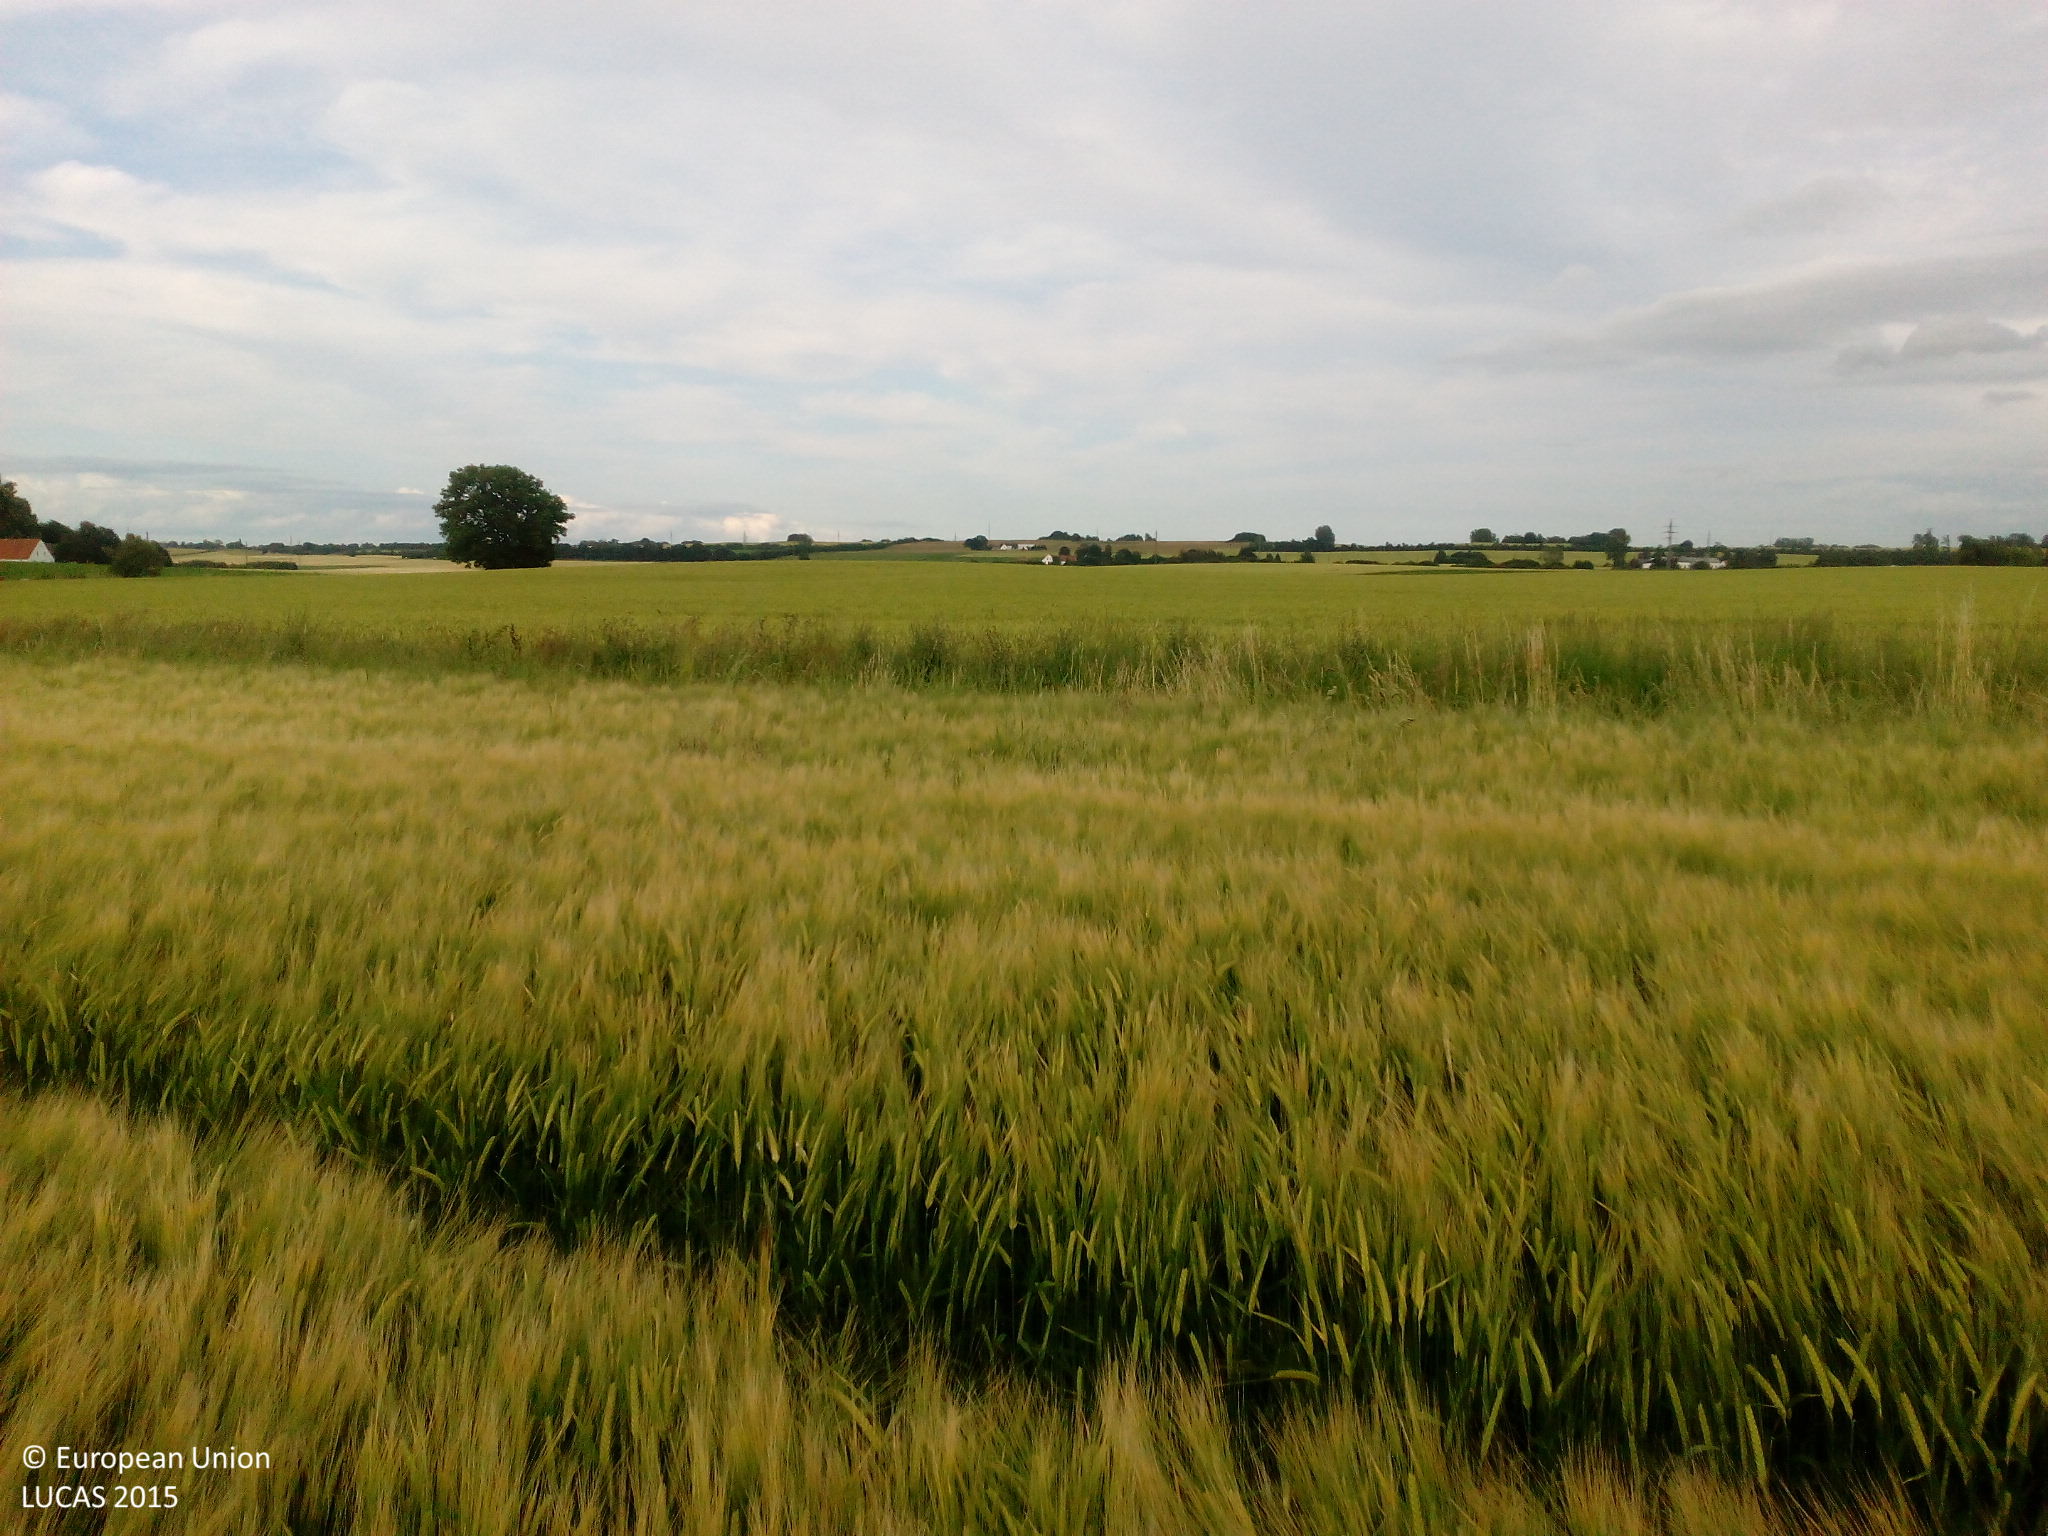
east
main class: Cropland
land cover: Barley
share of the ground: > 75 %
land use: Agriculture (excluding fallow land and kitchen gardens)
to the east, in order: Barley; Shruby margins; Paved roads, cycling and walking lanes; Shruby margins; Common wheat
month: July
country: DK
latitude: 55.3904
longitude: 11.2776
